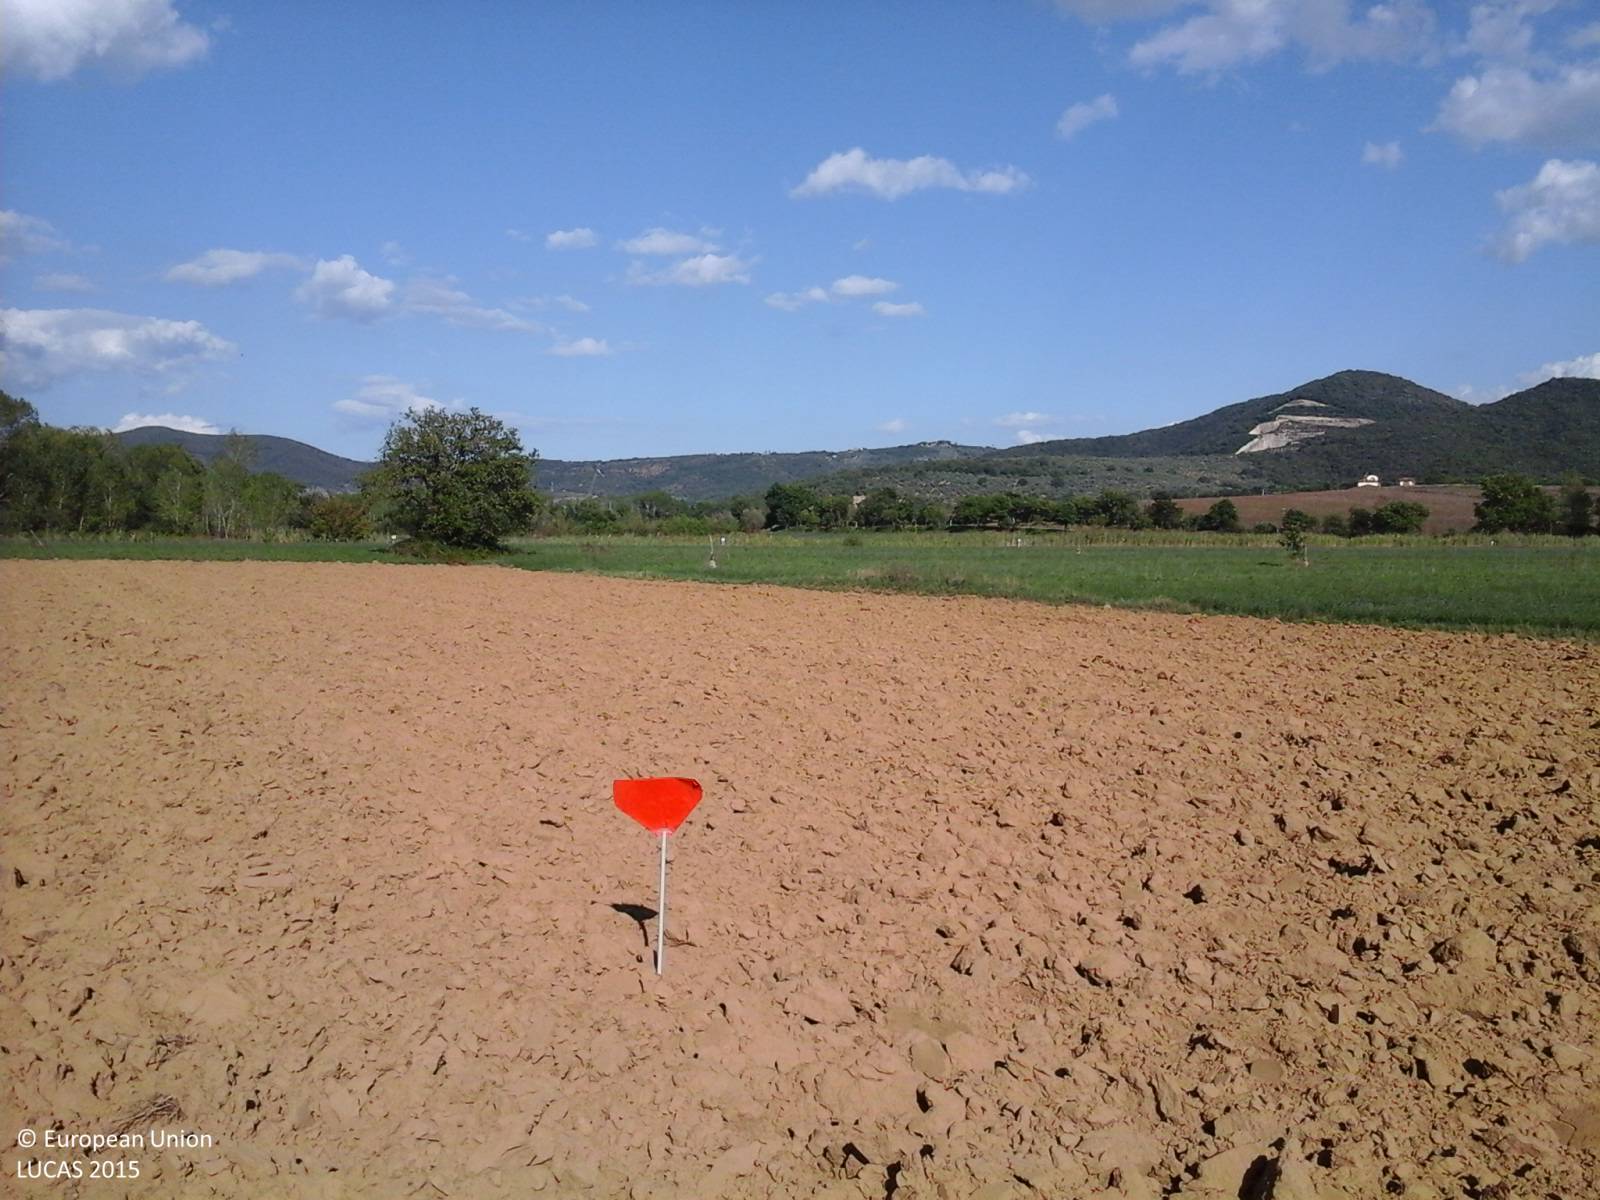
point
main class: Cropland
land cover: Common wheat
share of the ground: < 10 %
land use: Agriculture (excluding fallow land and kitchen gardens)
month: September
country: IT
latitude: 43.0474
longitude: 12.1175
